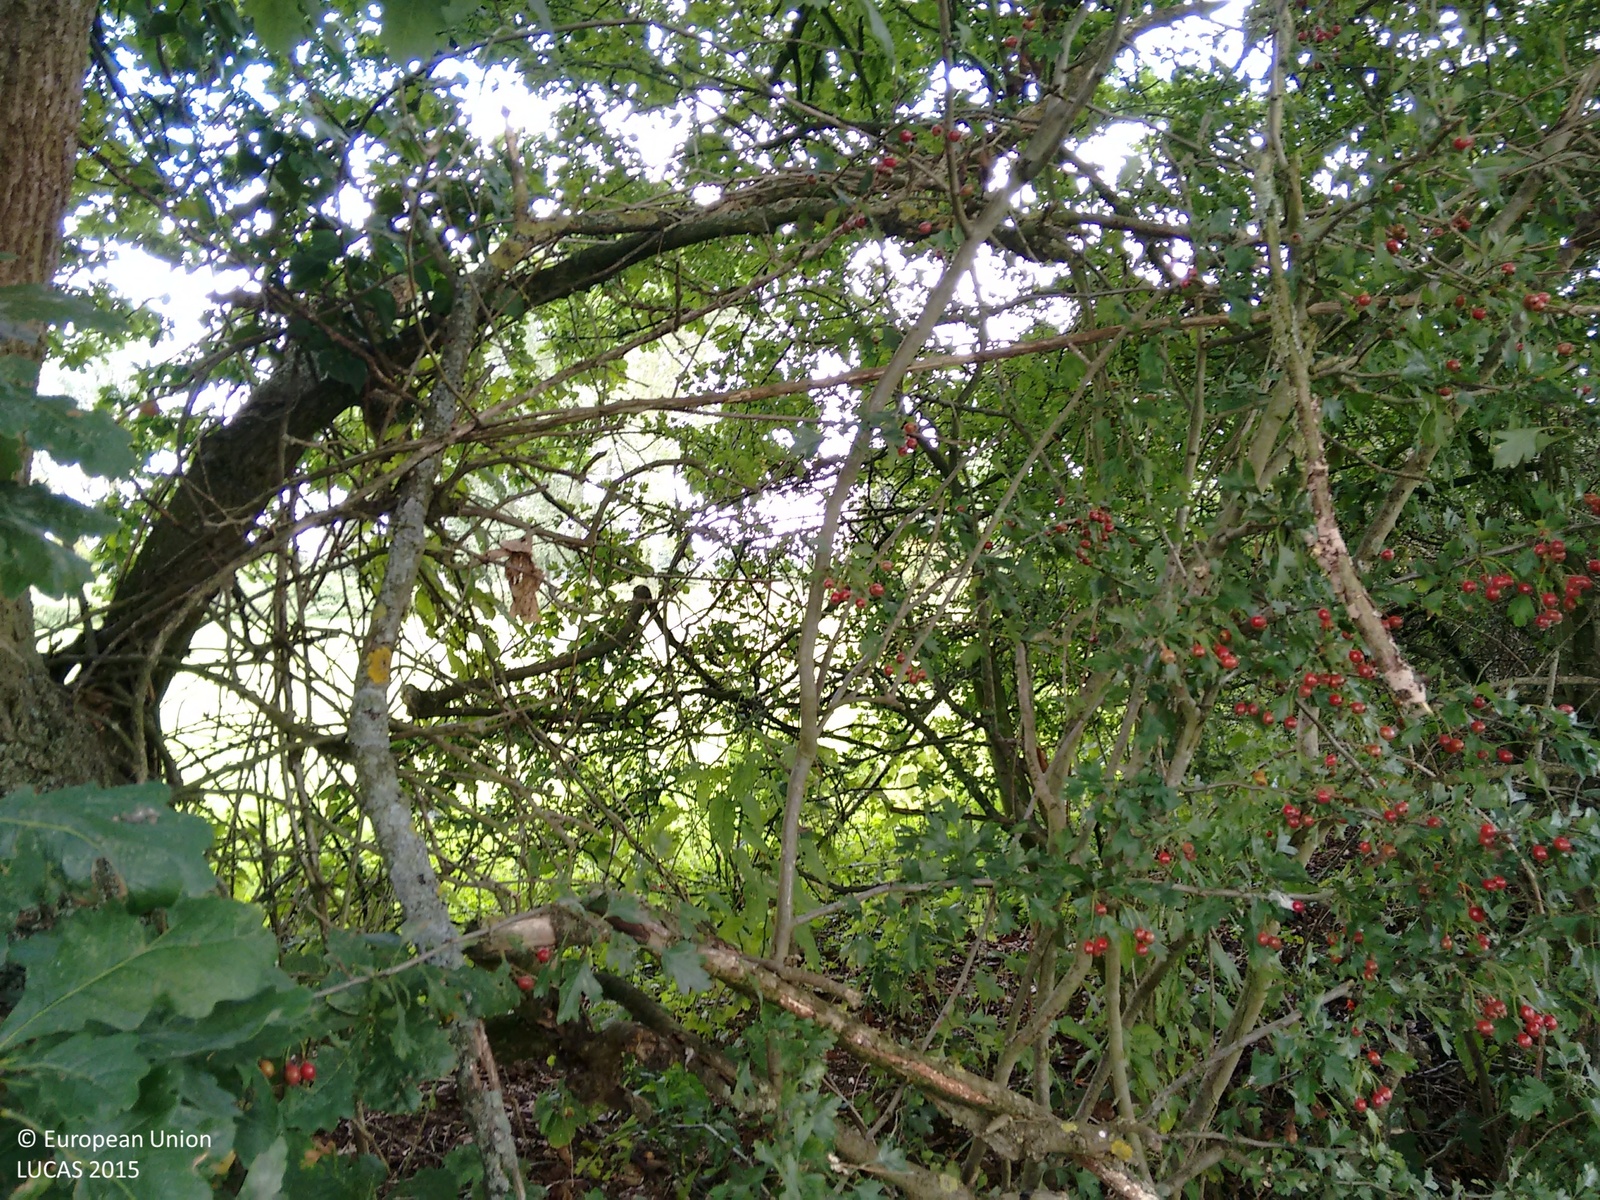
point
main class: Grassland
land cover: Grassland without tree/shrub cover
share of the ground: > 75 %
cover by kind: herbaceous plants 100 %
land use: Residential
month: September
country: GB
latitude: 52.5814
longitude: 0.8106
